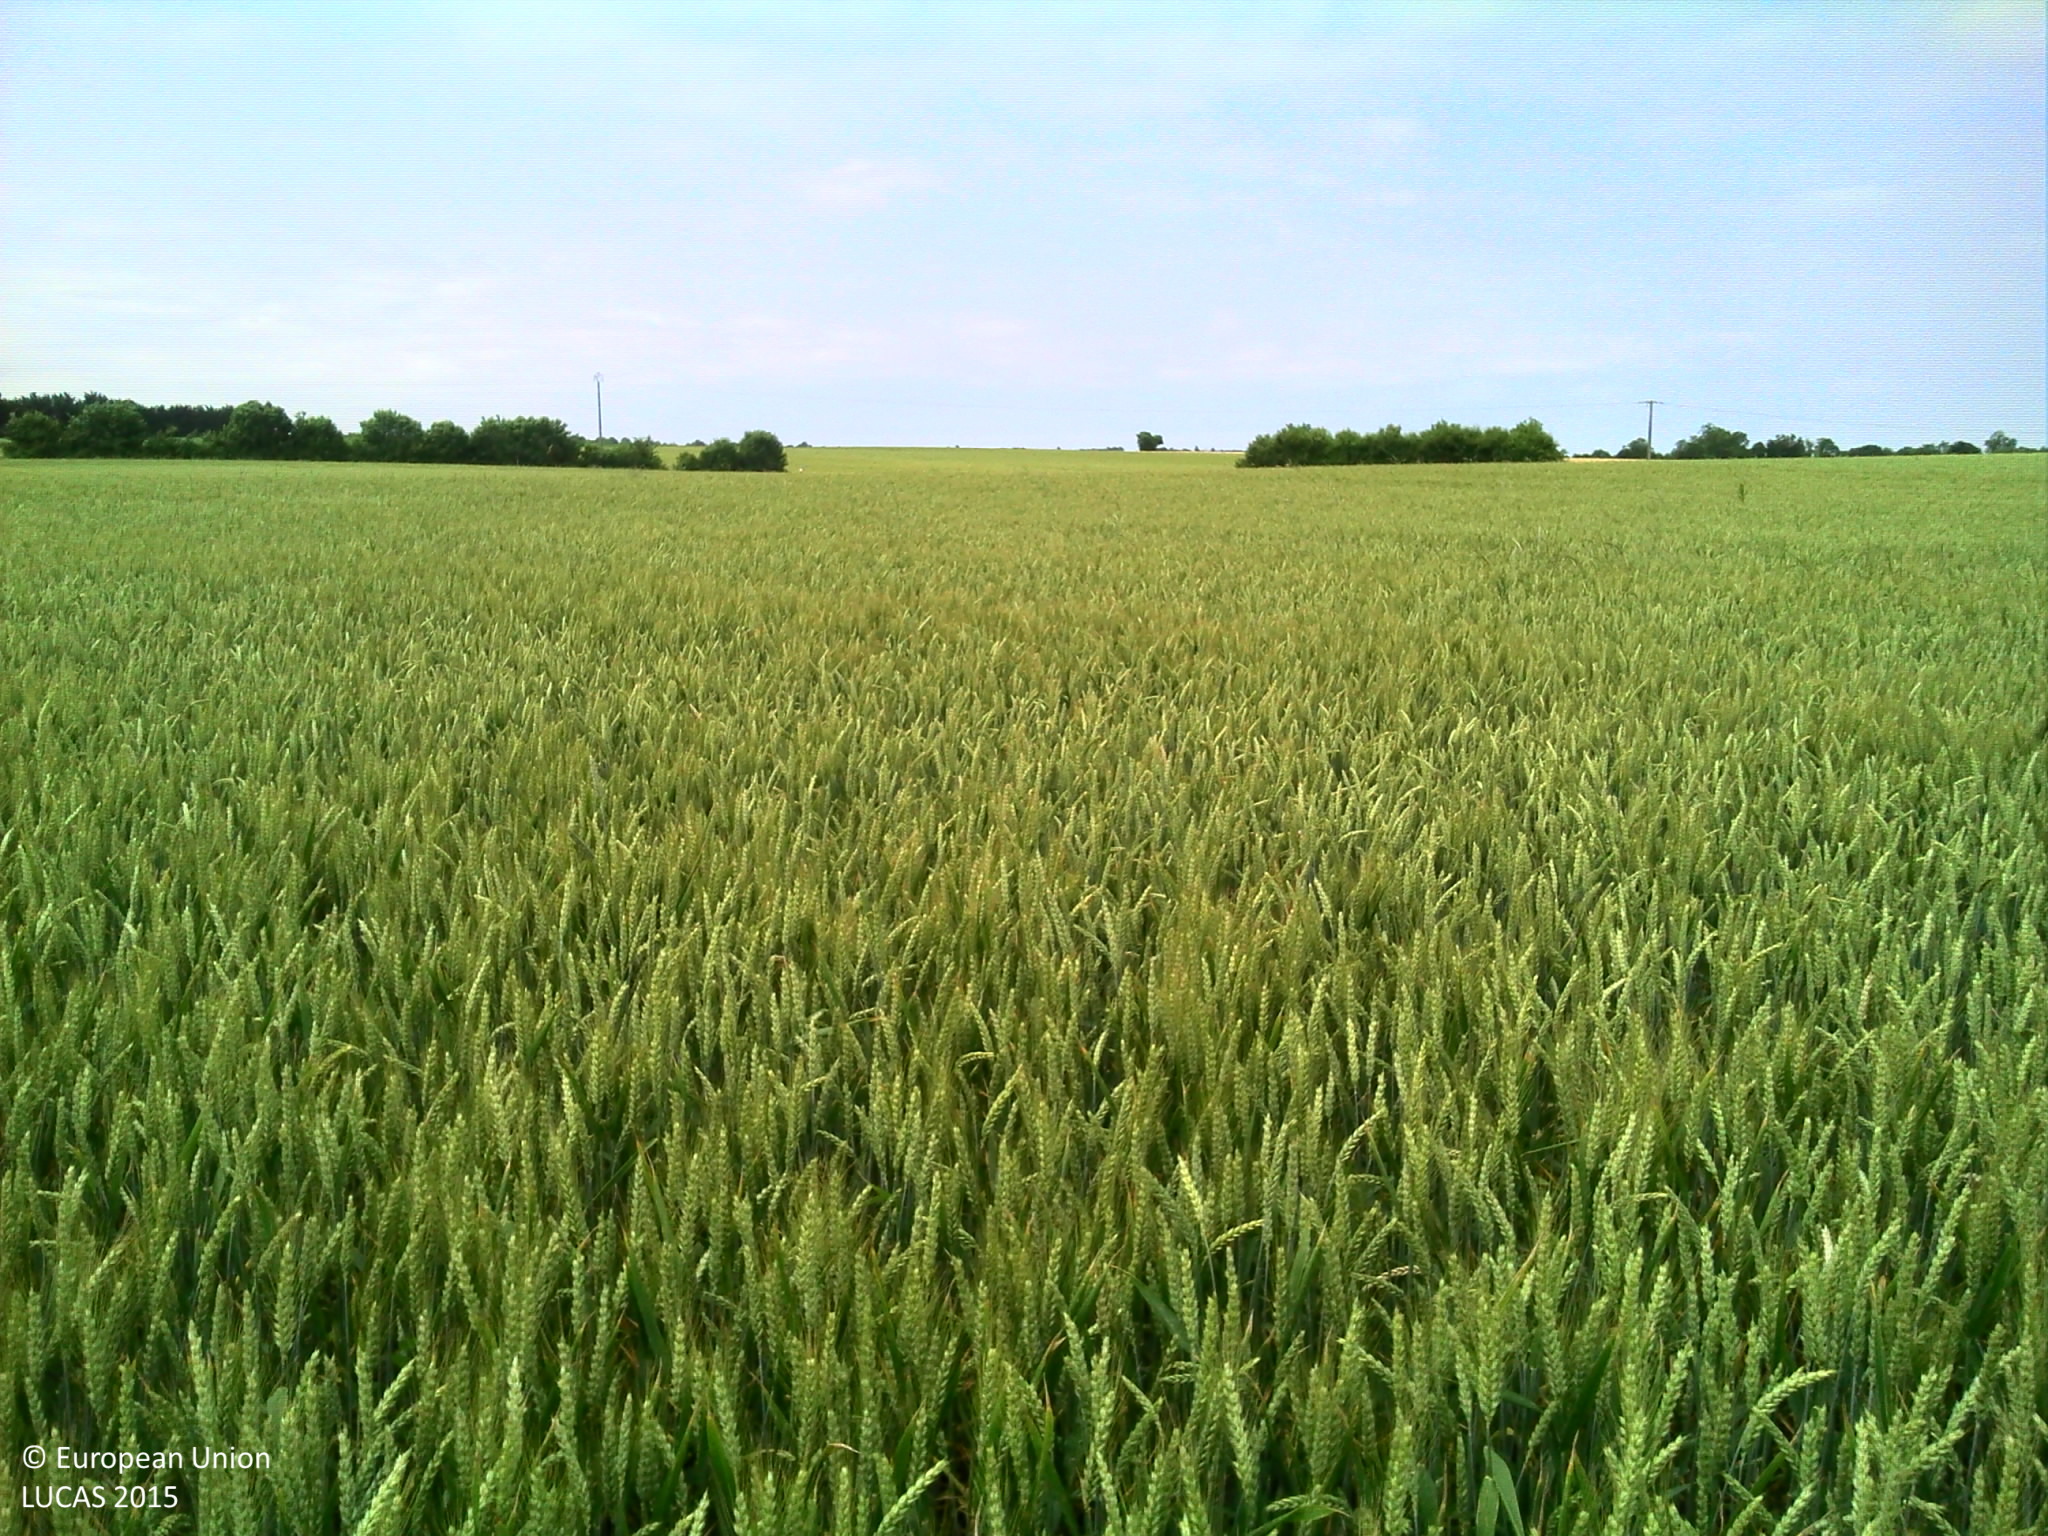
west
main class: Cropland
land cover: Common wheat
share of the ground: > 75 %
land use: Agriculture (excluding fallow land and kitchen gardens)
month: June
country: FR
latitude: 46.1690
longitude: -0.9481
